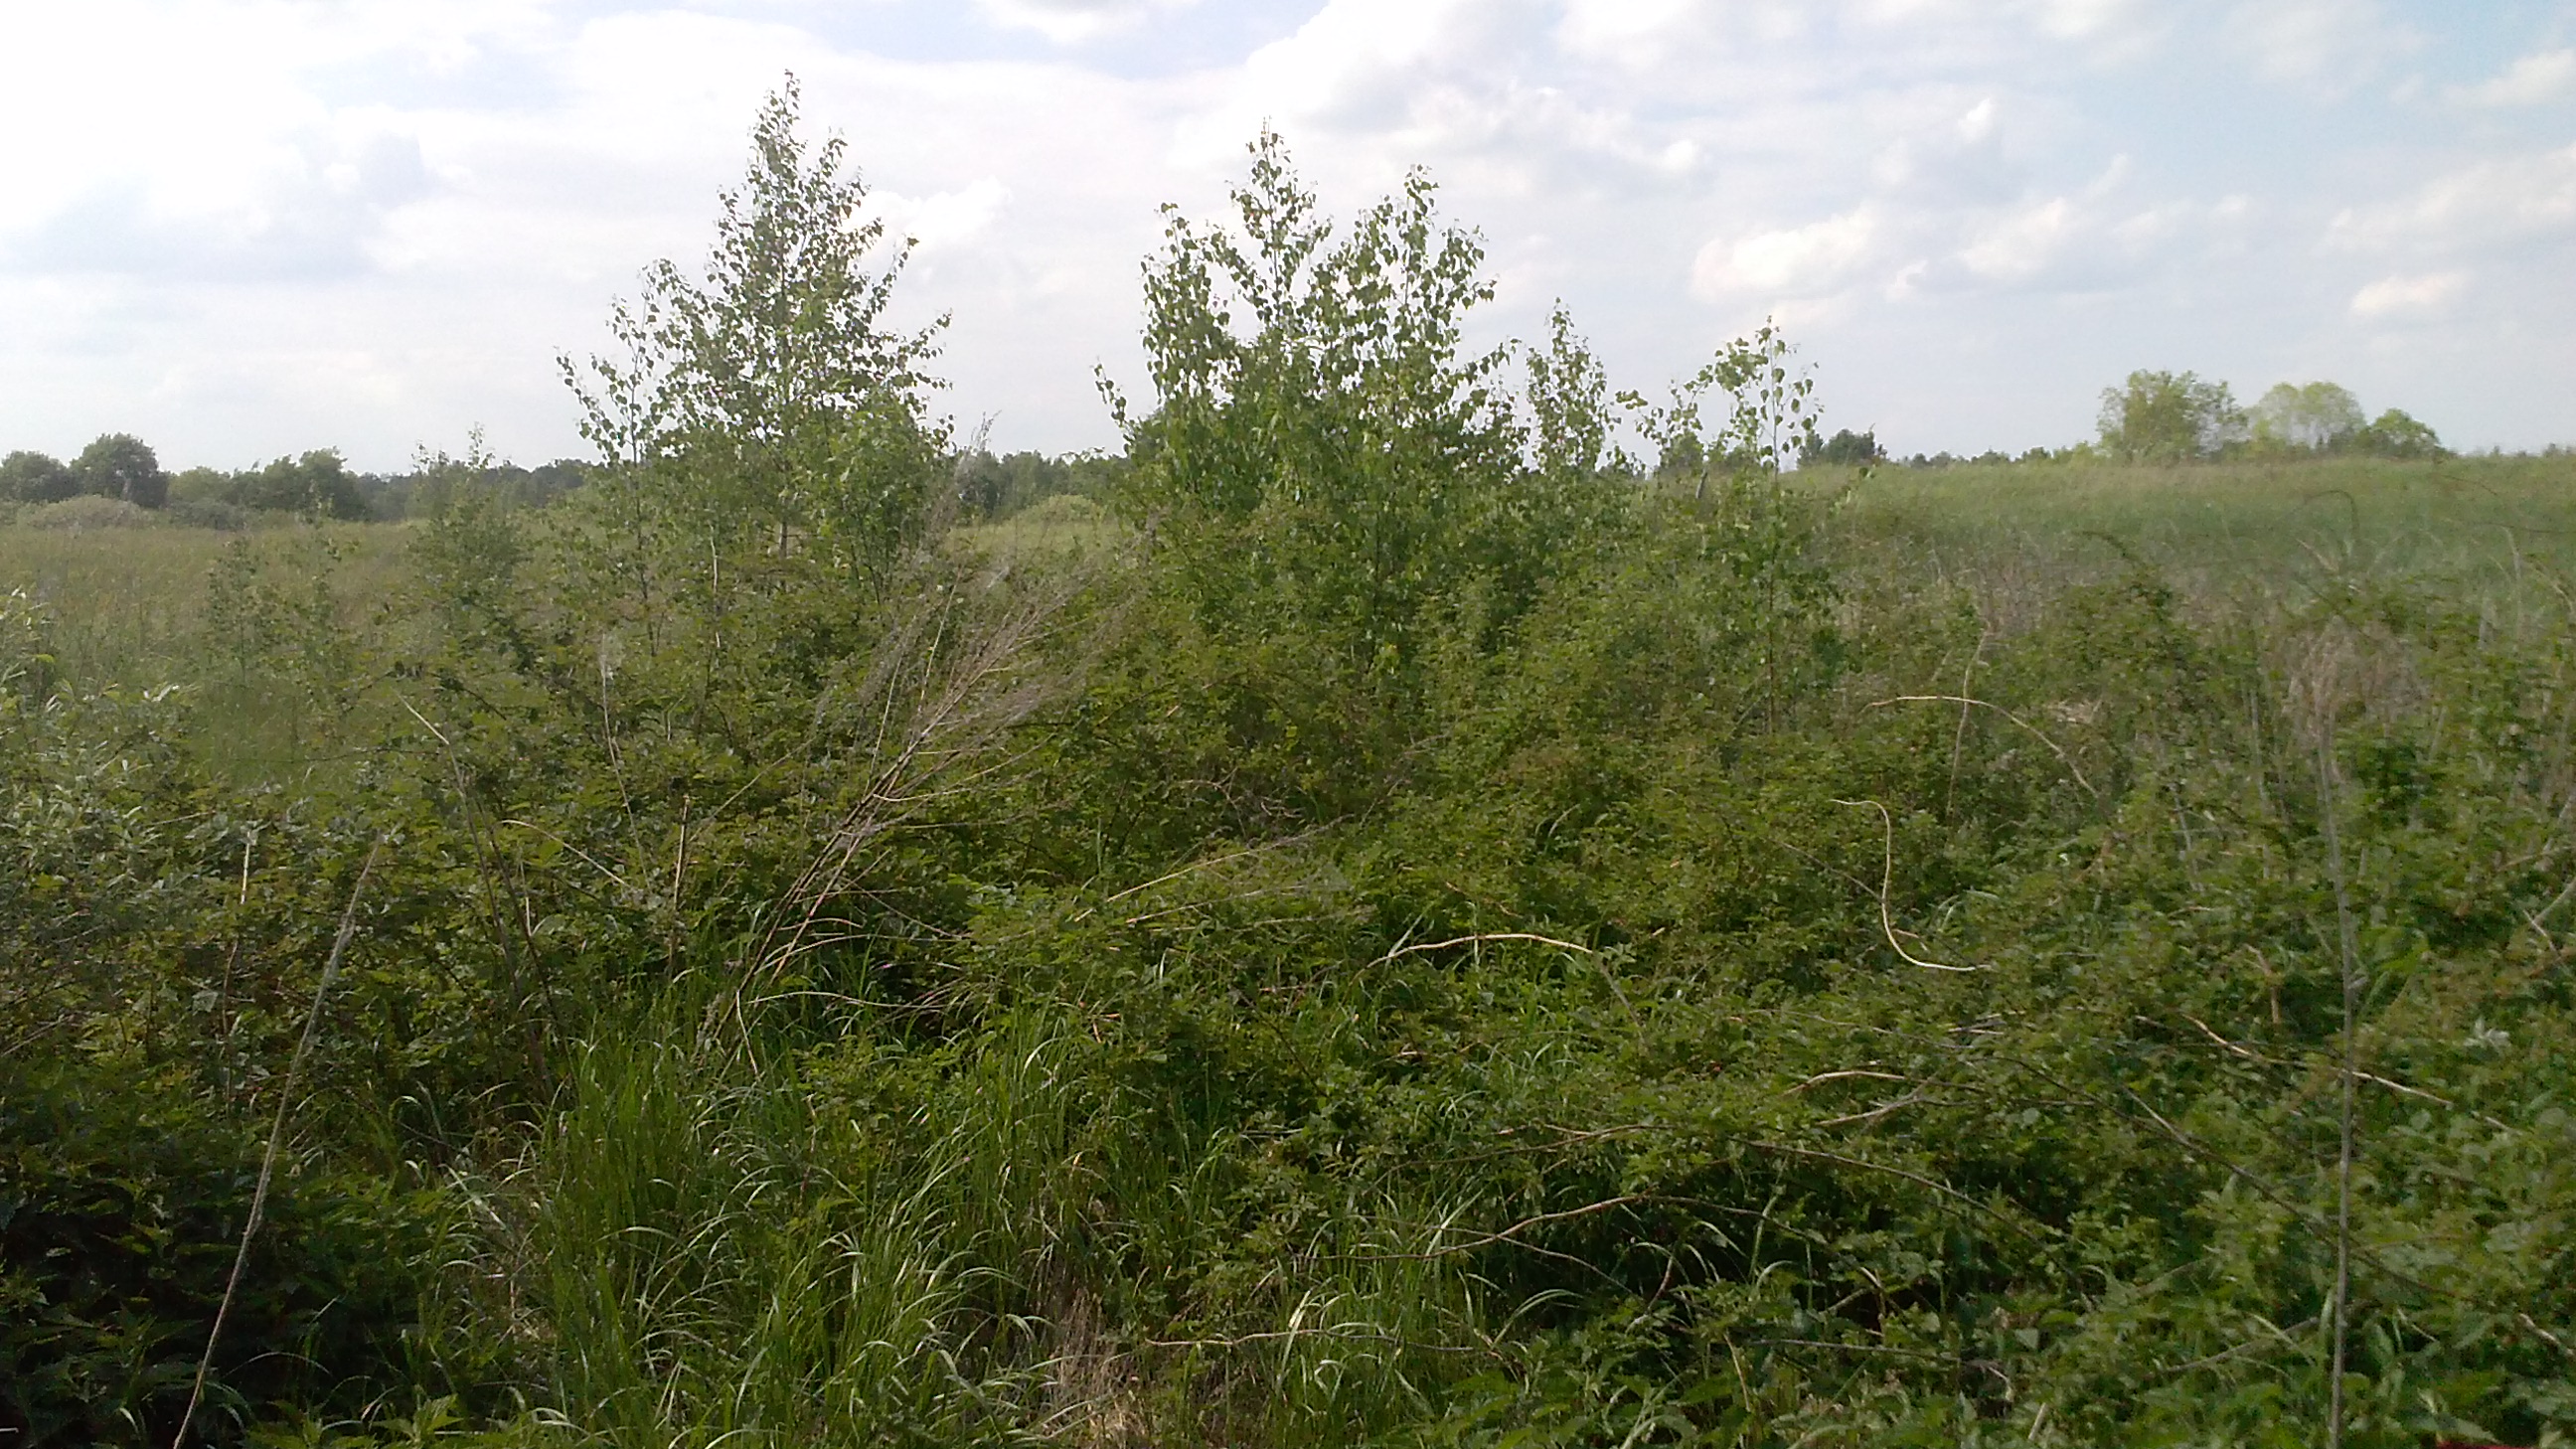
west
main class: Shrubland
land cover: Shrubland without tree cover
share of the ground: > 75 %
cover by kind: shrubs 90 %, herbaceous plants 10 %
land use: Semi-natural and natural areas not in use
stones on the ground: < 10 %
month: June
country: LV
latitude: 56.2345
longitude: 28.0922
